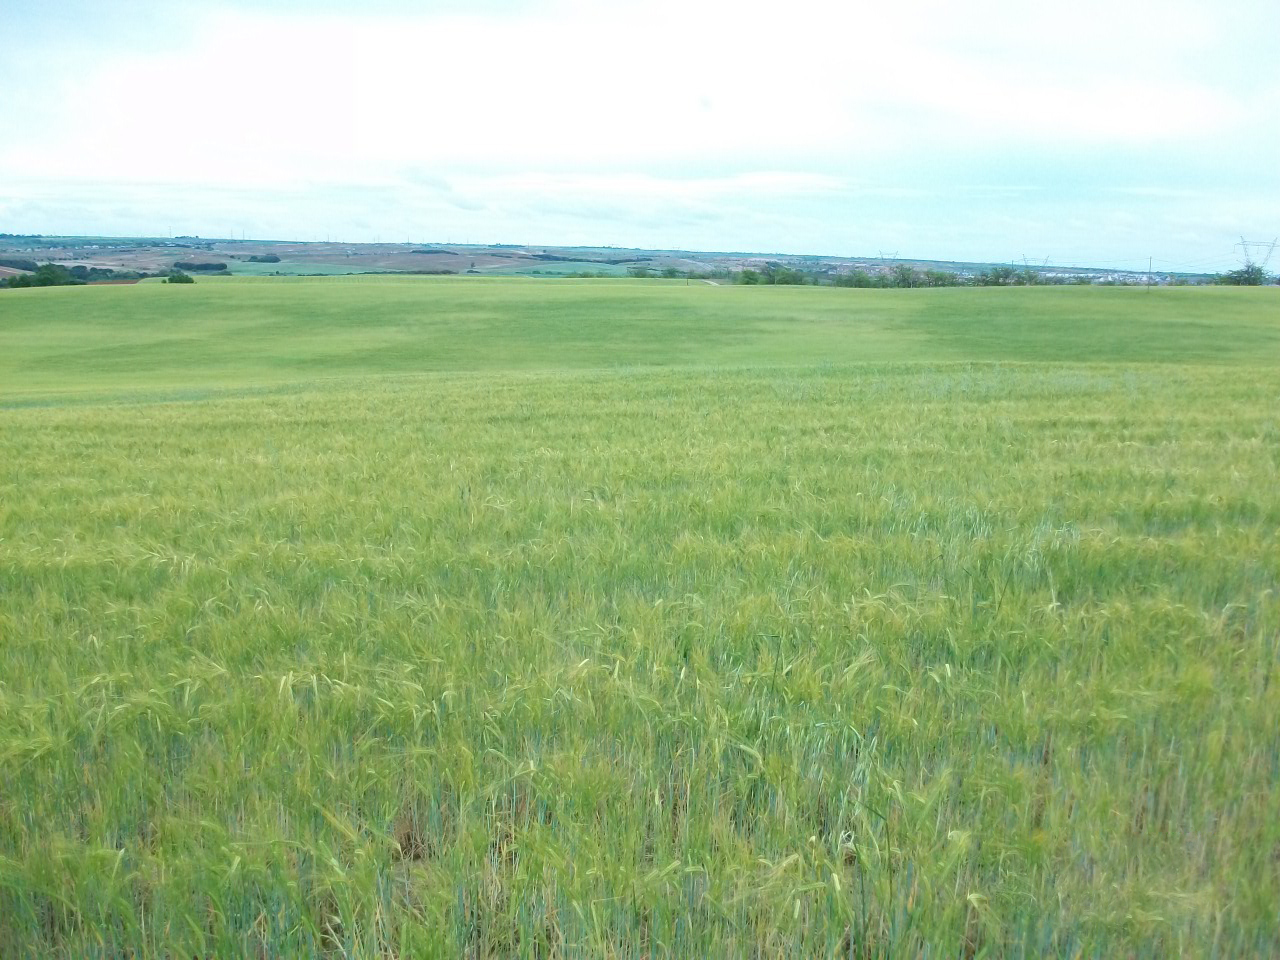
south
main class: Cropland
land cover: Barley
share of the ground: > 75 %
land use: Agriculture (excluding fallow land and kitchen gardens)
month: April
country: ES
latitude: 40.2975
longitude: -3.9091
